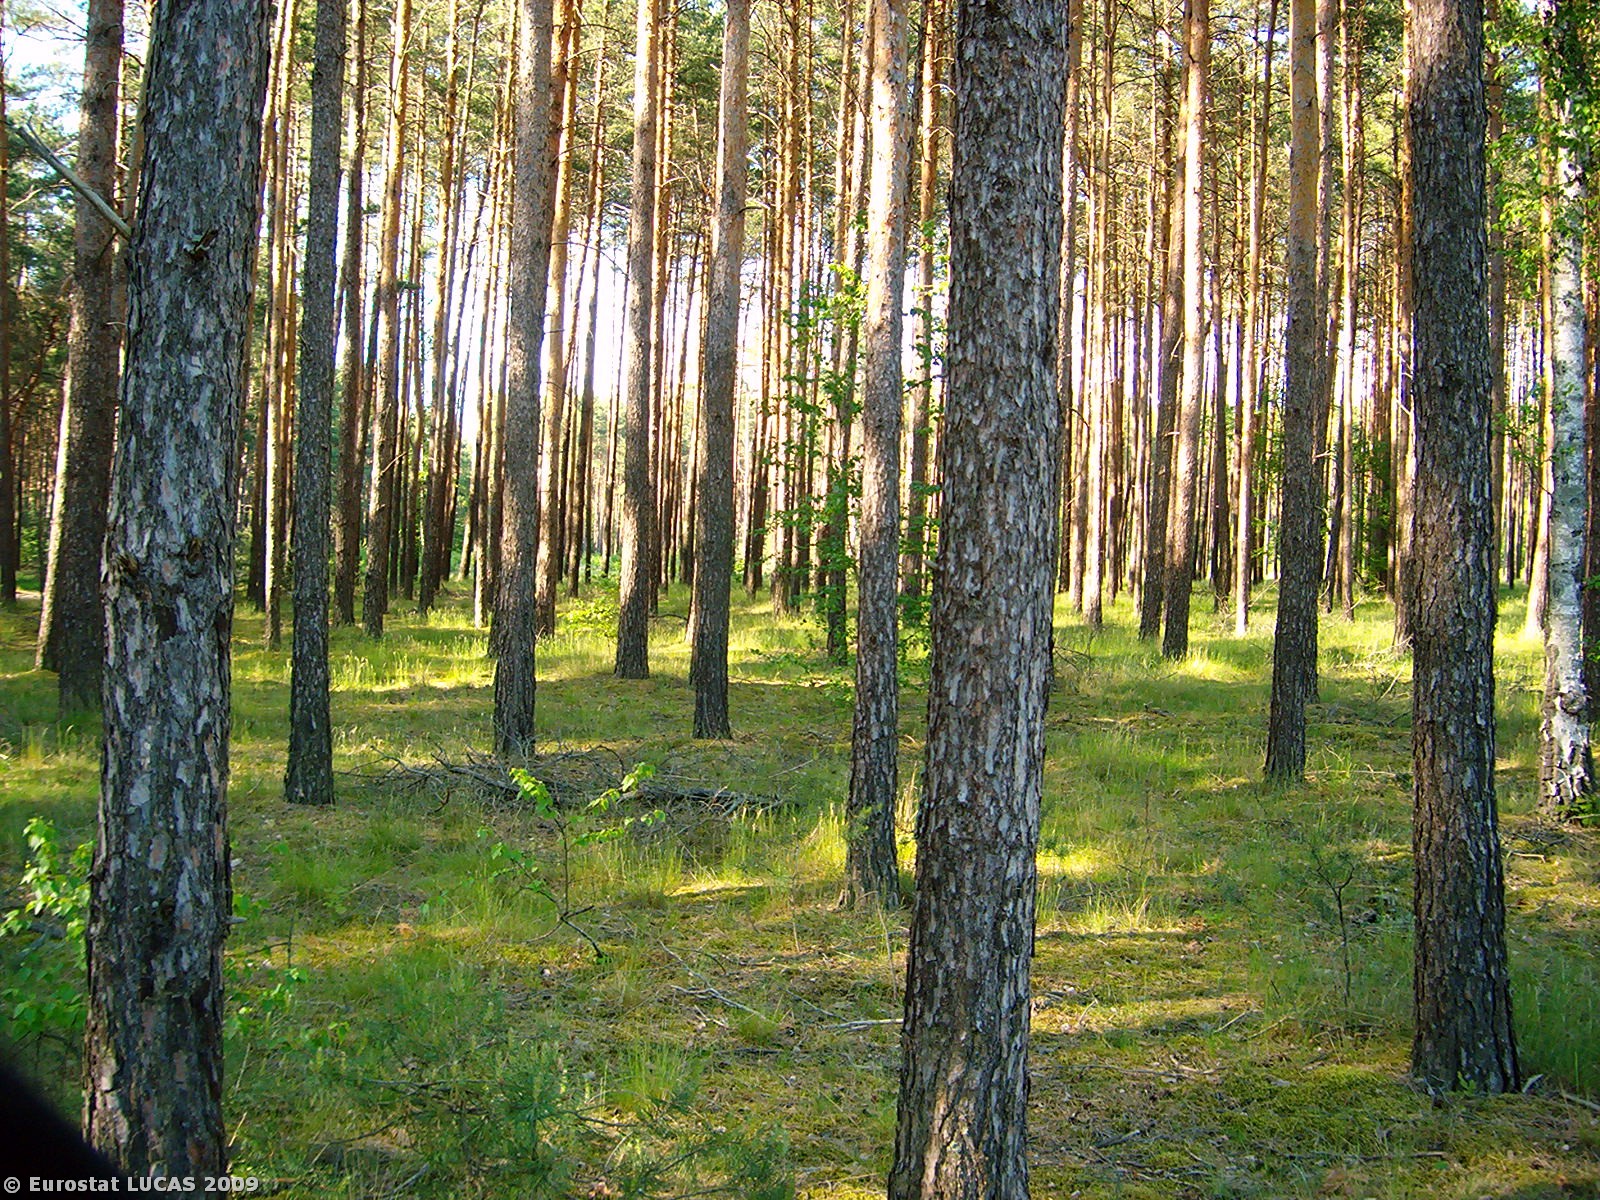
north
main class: Woodland
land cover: Coniferous woodland
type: hemiboreal forest and nemoral coniferous forest and mixed broadleaved-coniferous forest
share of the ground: 50 - 75 %
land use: Forestry
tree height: > 5 m
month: May
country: PL
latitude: 52.7236
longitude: 16.4775
